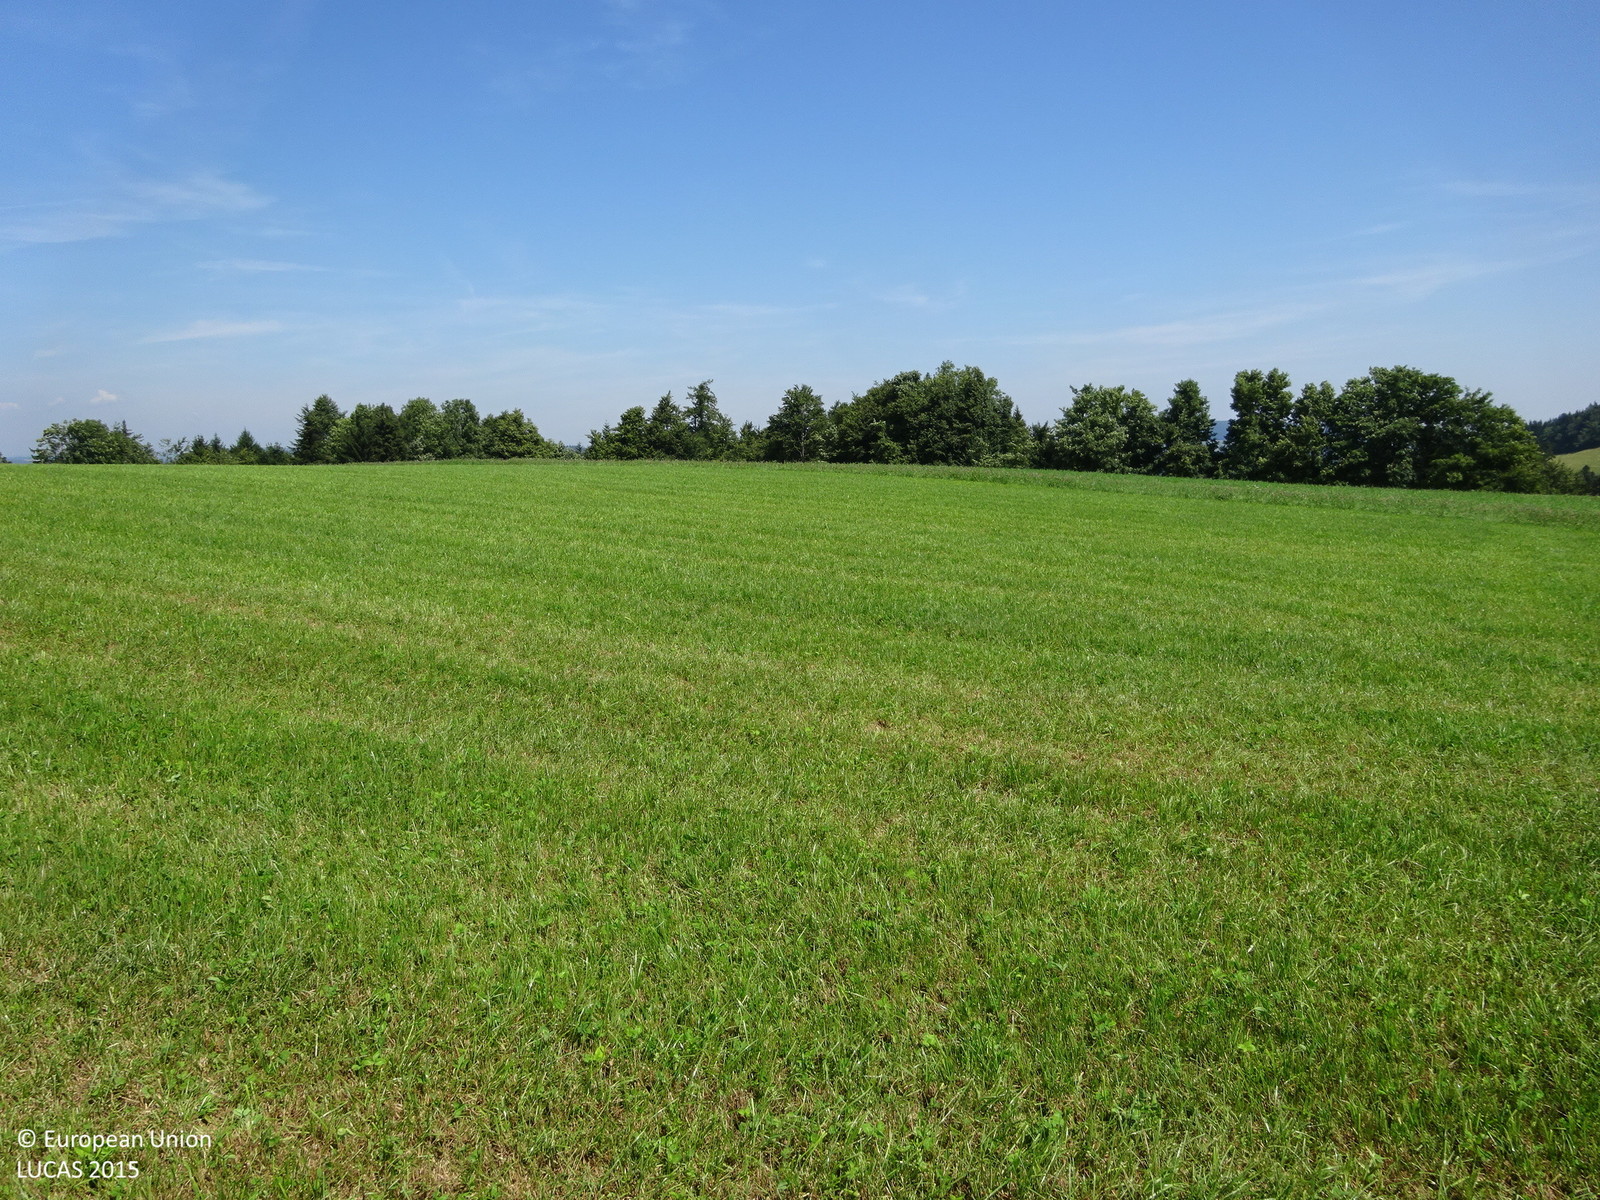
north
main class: Cropland
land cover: Temporary grasslands
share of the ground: > 75 %
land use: Agriculture (excluding fallow land and kitchen gardens)
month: August
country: AT
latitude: 47.4939
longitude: 16.1217
